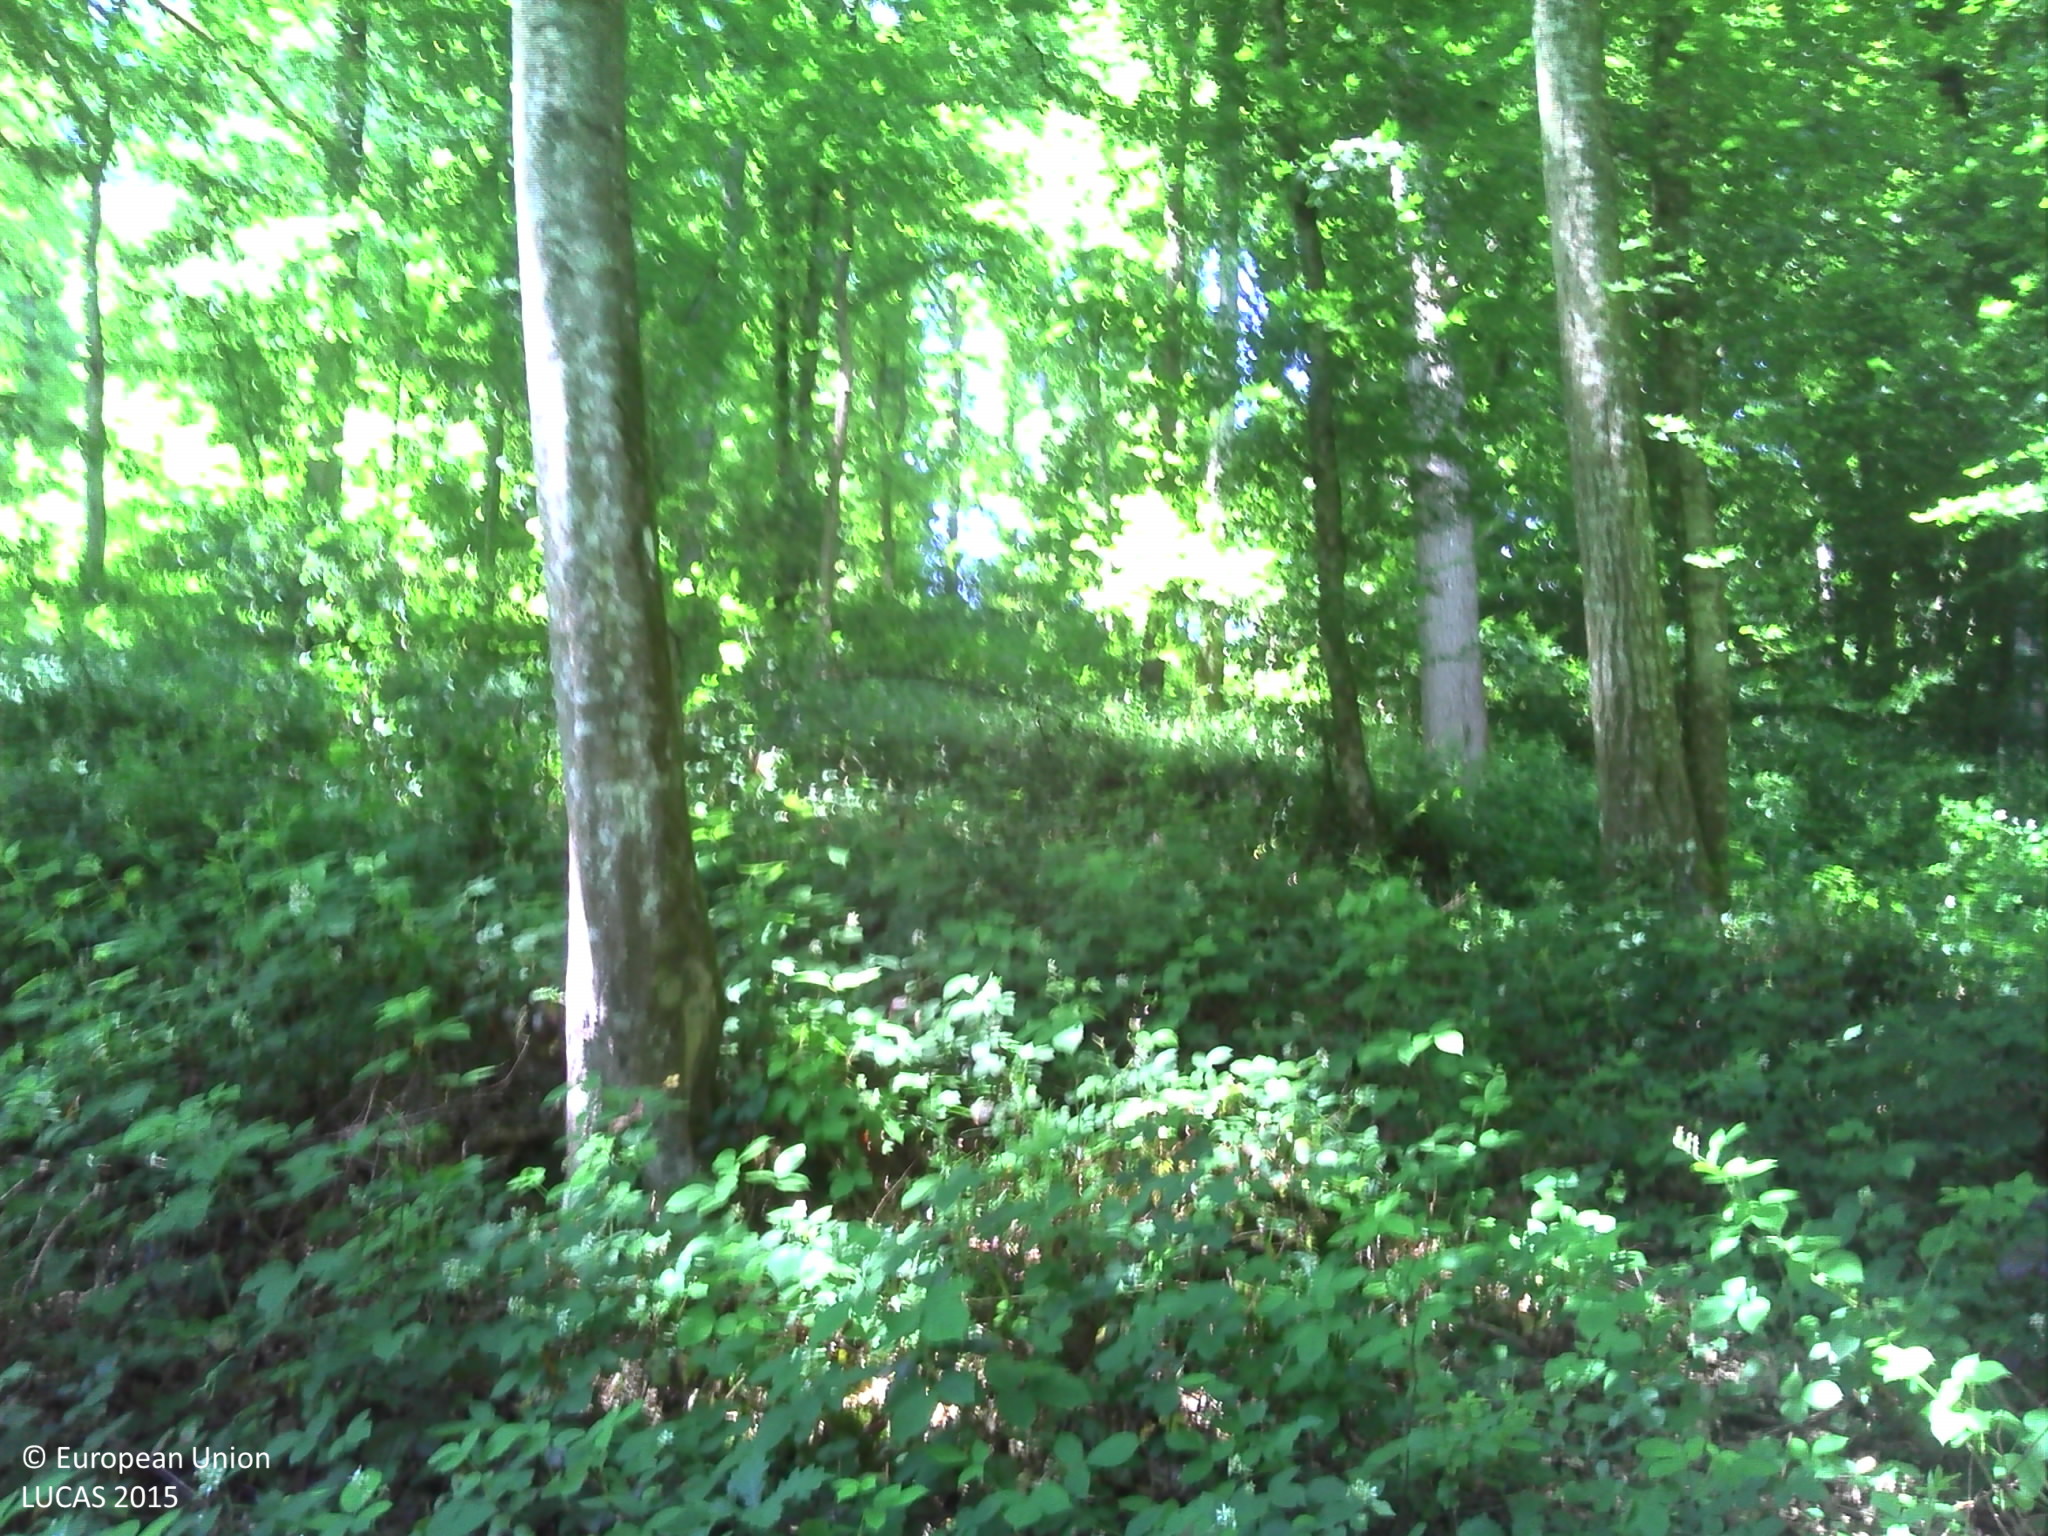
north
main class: Woodland
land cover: Broadleaved woodland
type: mesophytic deciduous forest
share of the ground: > 75 %
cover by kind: broadleaved forest trees 80 %, herbaceous plants 10 %, consolidated bare surface 10 %
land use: Forestry
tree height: > 5 m
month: June
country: FR
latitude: 49.1287
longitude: 1.0848
